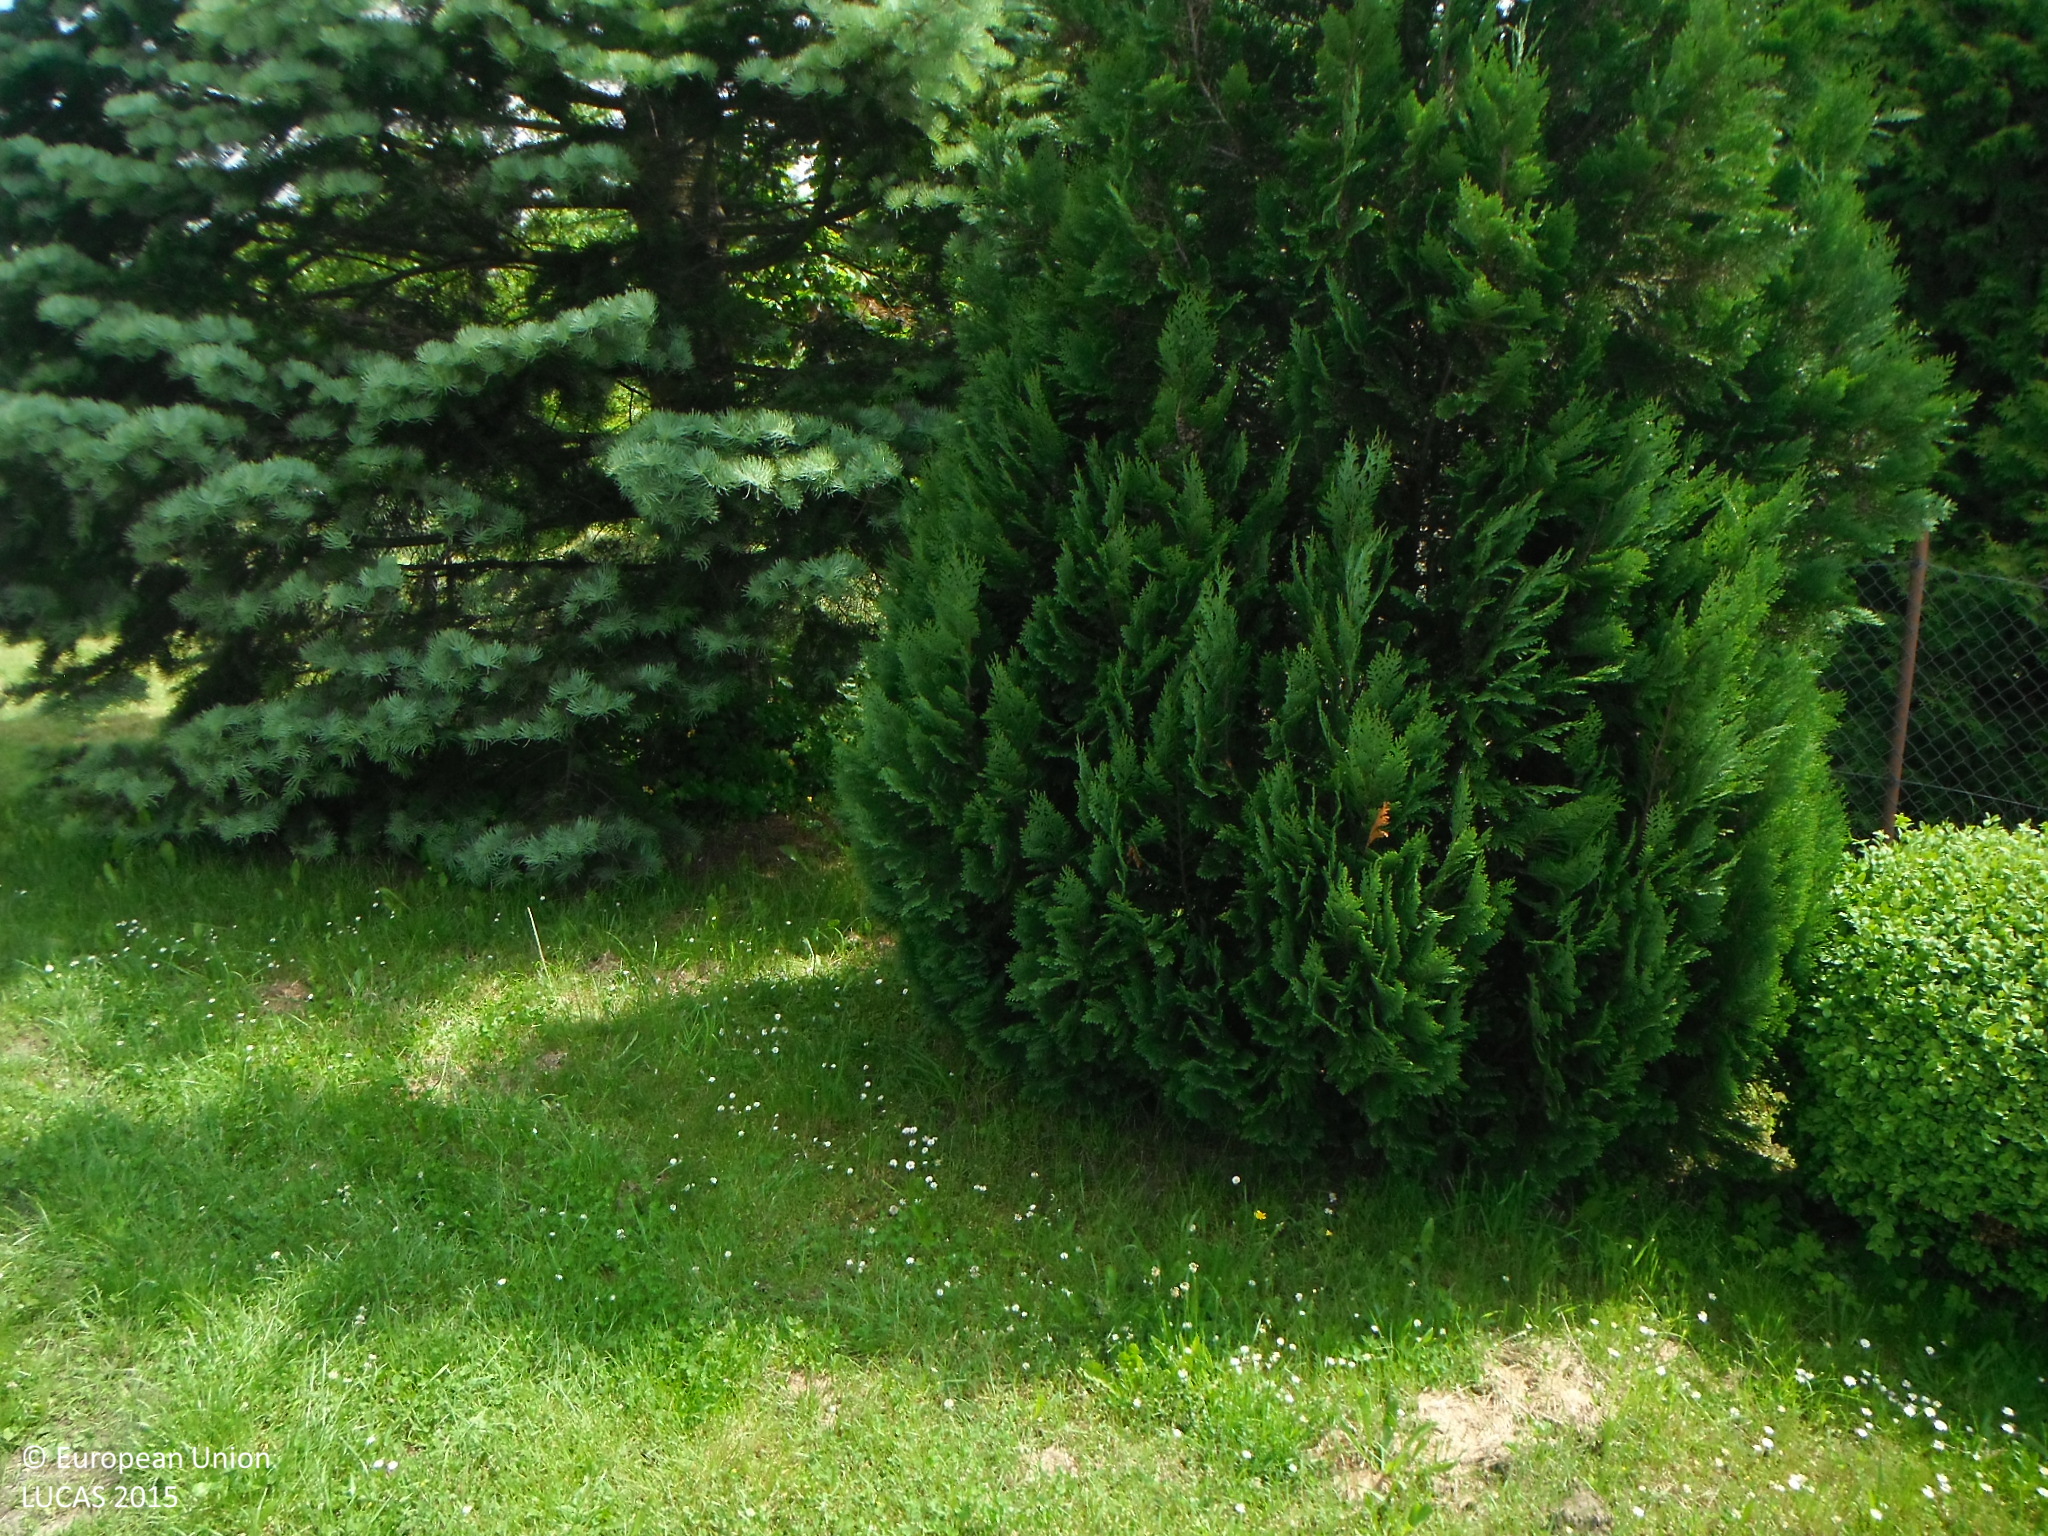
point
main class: Grassland
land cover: Grassland with sparse tree/shrub cover
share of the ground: > 75 %
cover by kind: herbaceous plants 85 %, shrubs 10 %, coniferous forest trees 5 %
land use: Residential
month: June
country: SK
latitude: 48.8120
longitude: 19.4622
